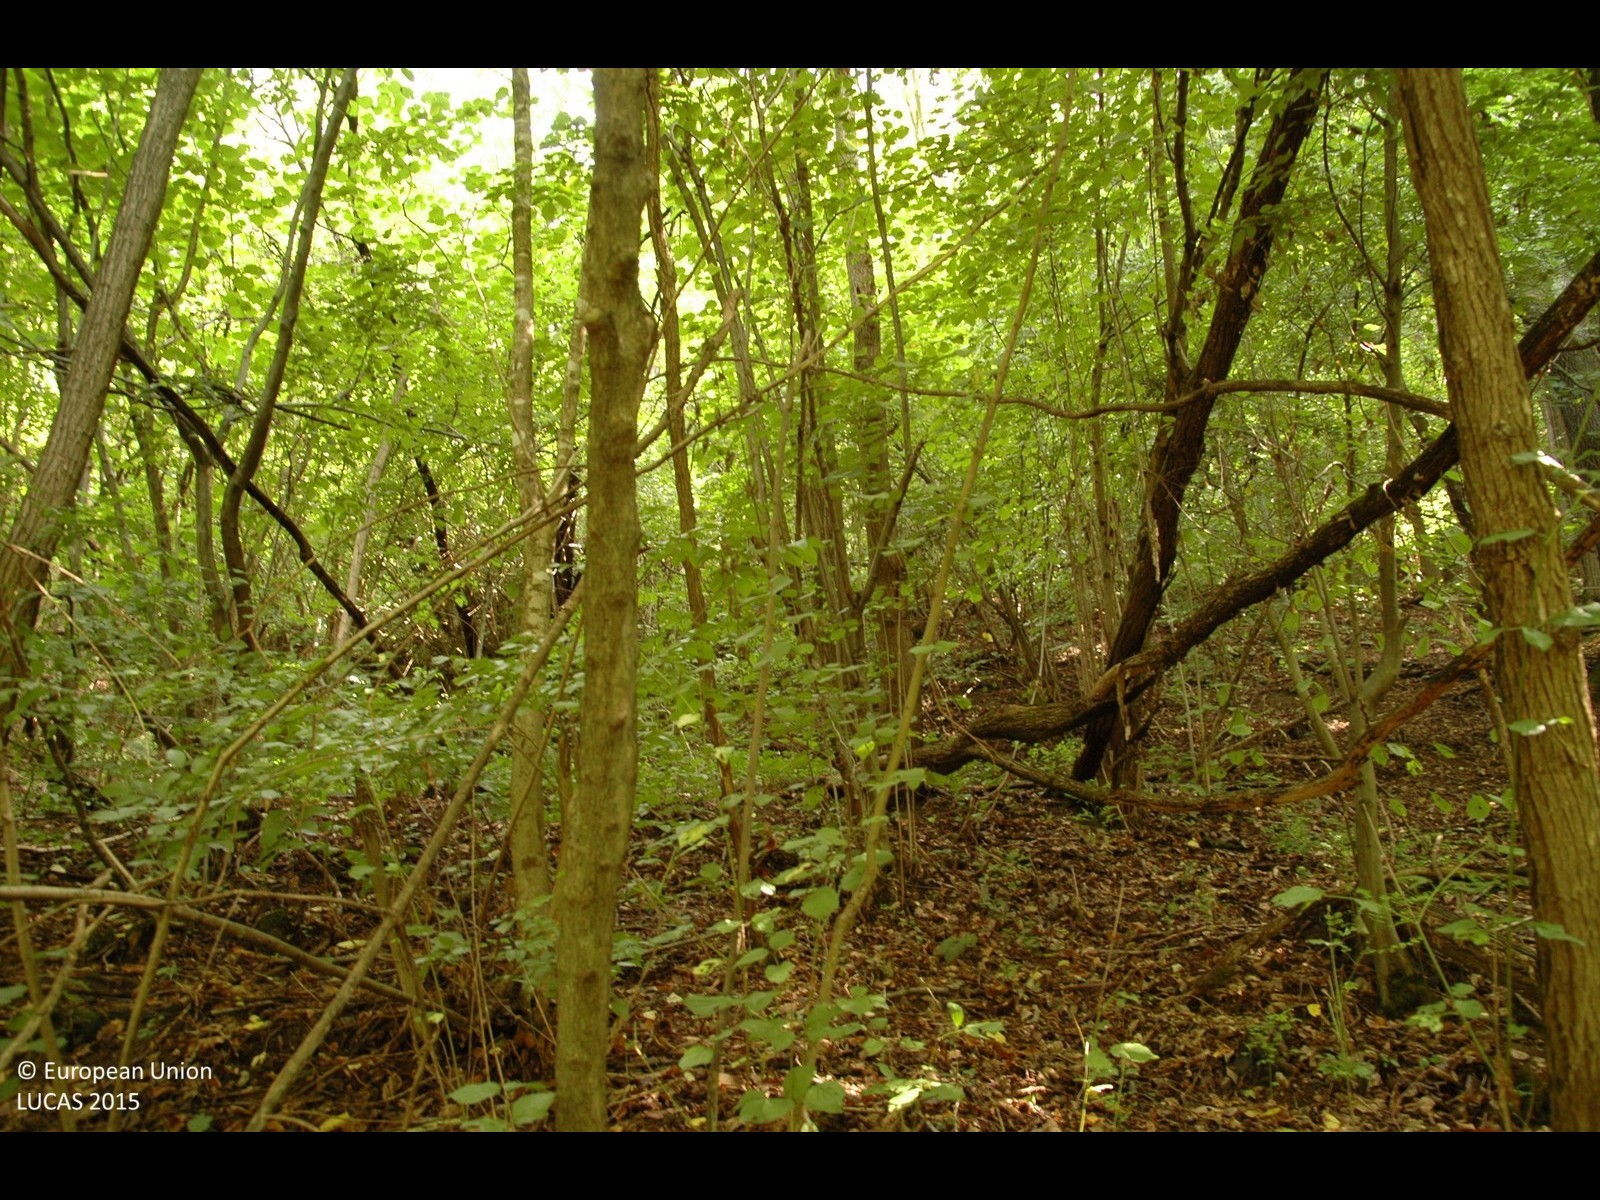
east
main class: Woodland
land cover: Broadleaved woodland
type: mesophytic deciduous forest
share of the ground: > 75 %
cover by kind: broadleaved forest trees 100 %
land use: Forestry
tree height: > 5 m
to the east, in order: Broadleaved woodland; Grassland with sparse tree/shrub cover; Broadleaved woodland
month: August
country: HR
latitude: 45.9408
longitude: 16.1255
